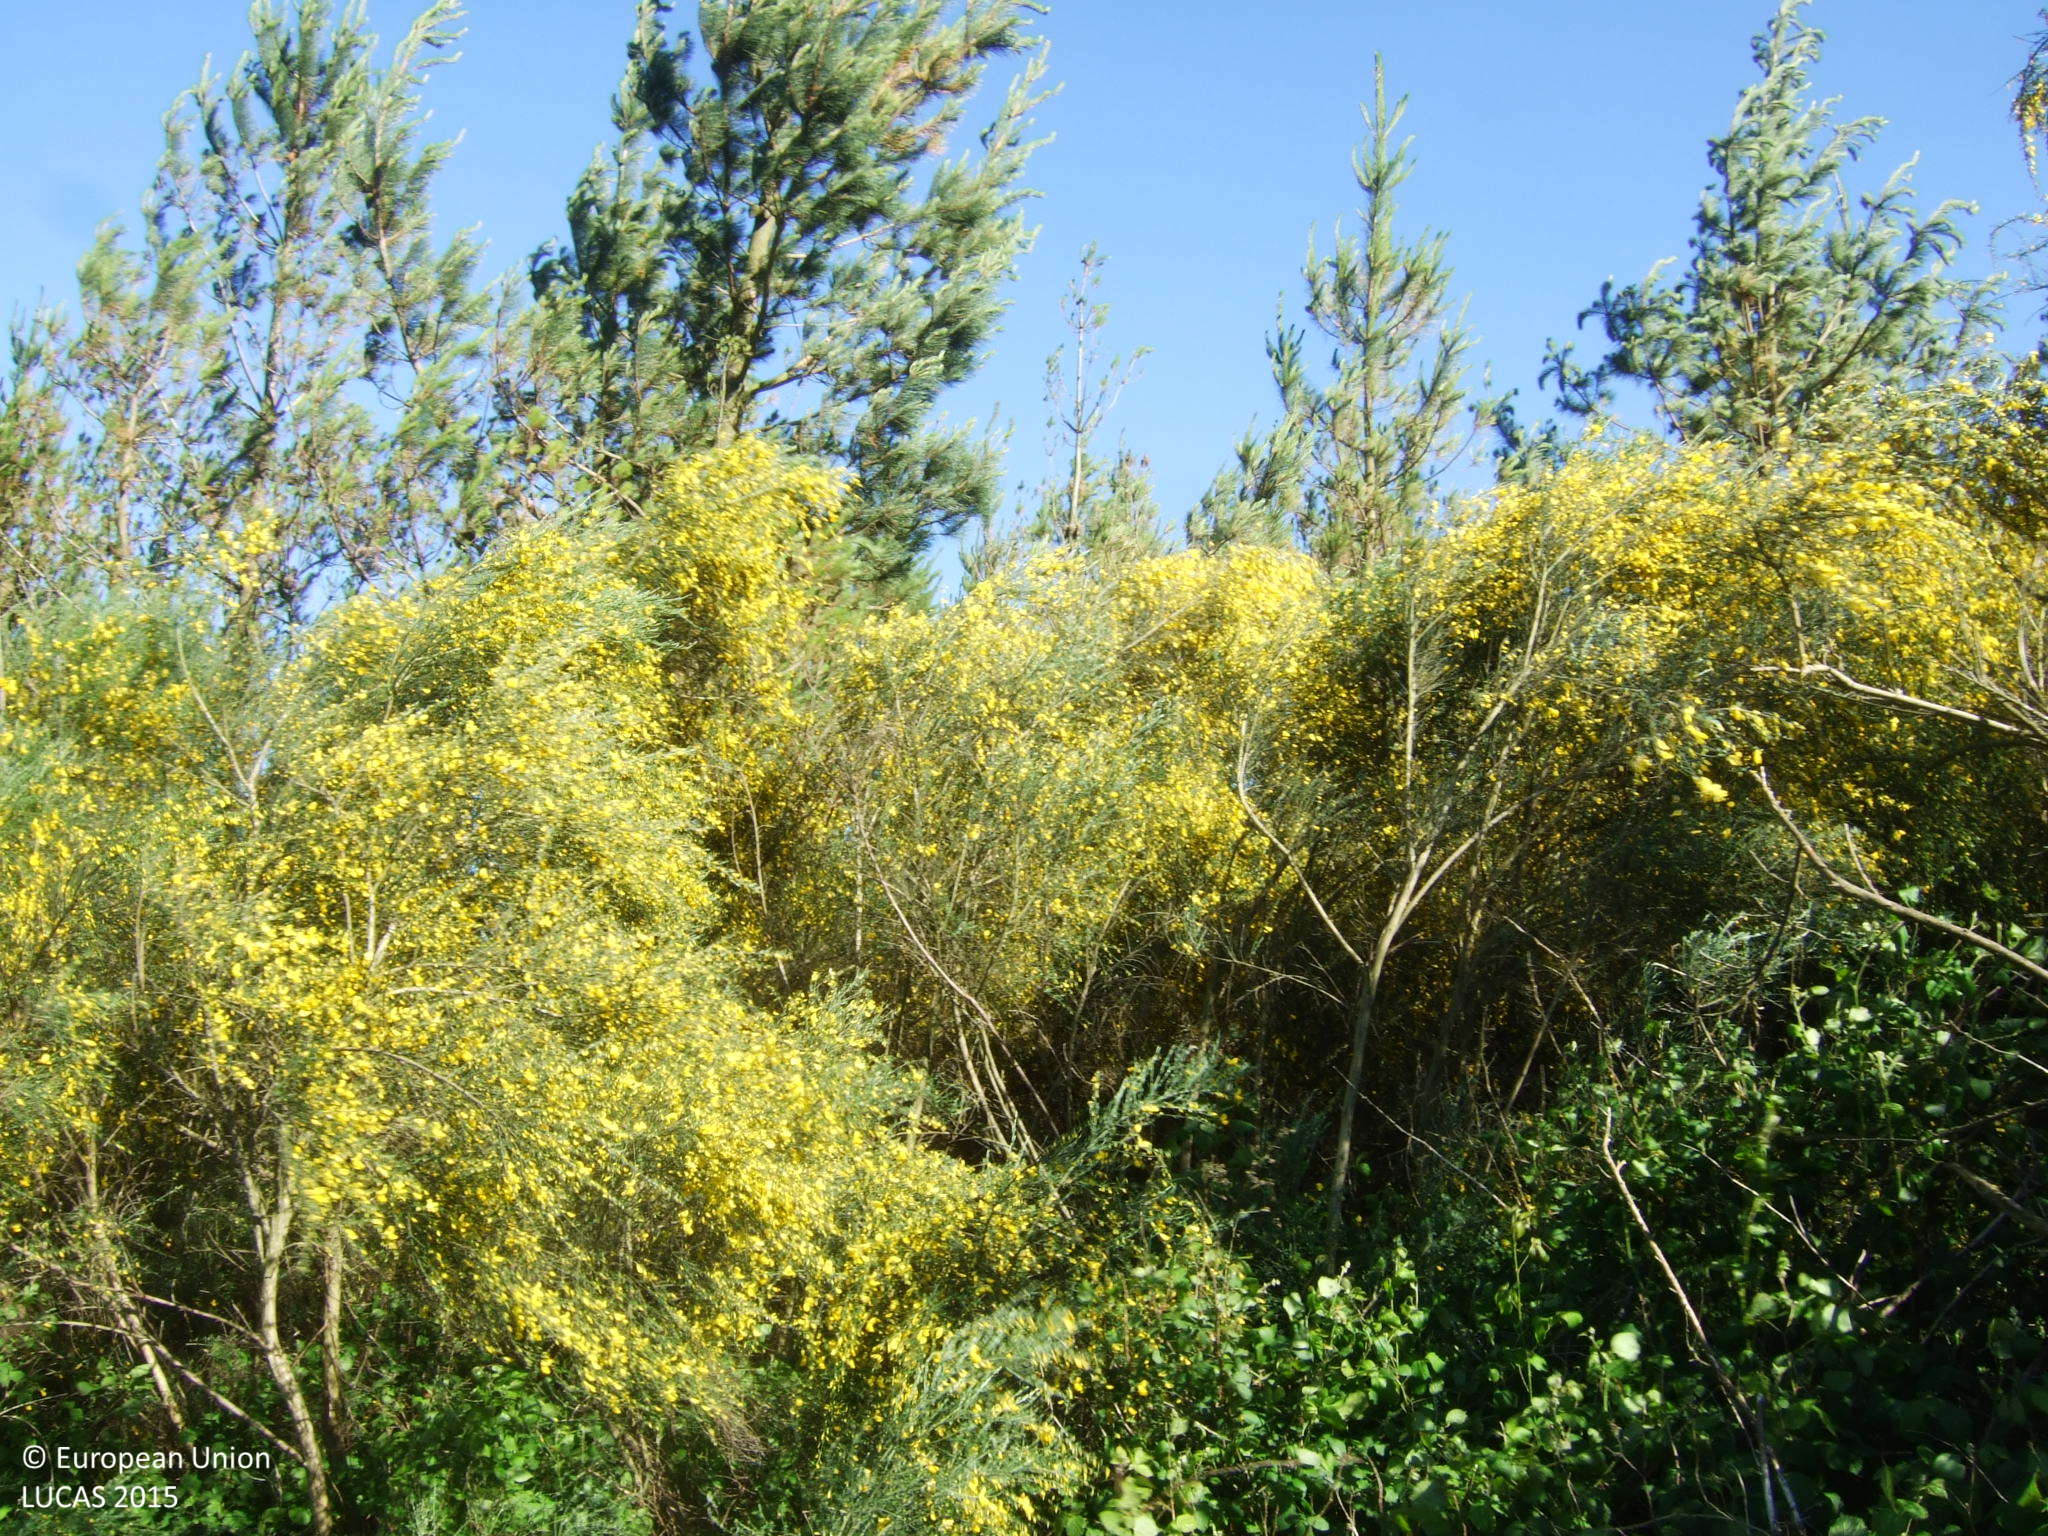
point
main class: Woodland
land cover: Pine dominated coniferous woodland
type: exotic forest
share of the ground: > 75 %
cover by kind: coniferous forest trees 75 %, shrubs 25 %
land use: Forestry
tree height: < 5 m
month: May
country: ES
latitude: 42.6905
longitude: -7.5641
